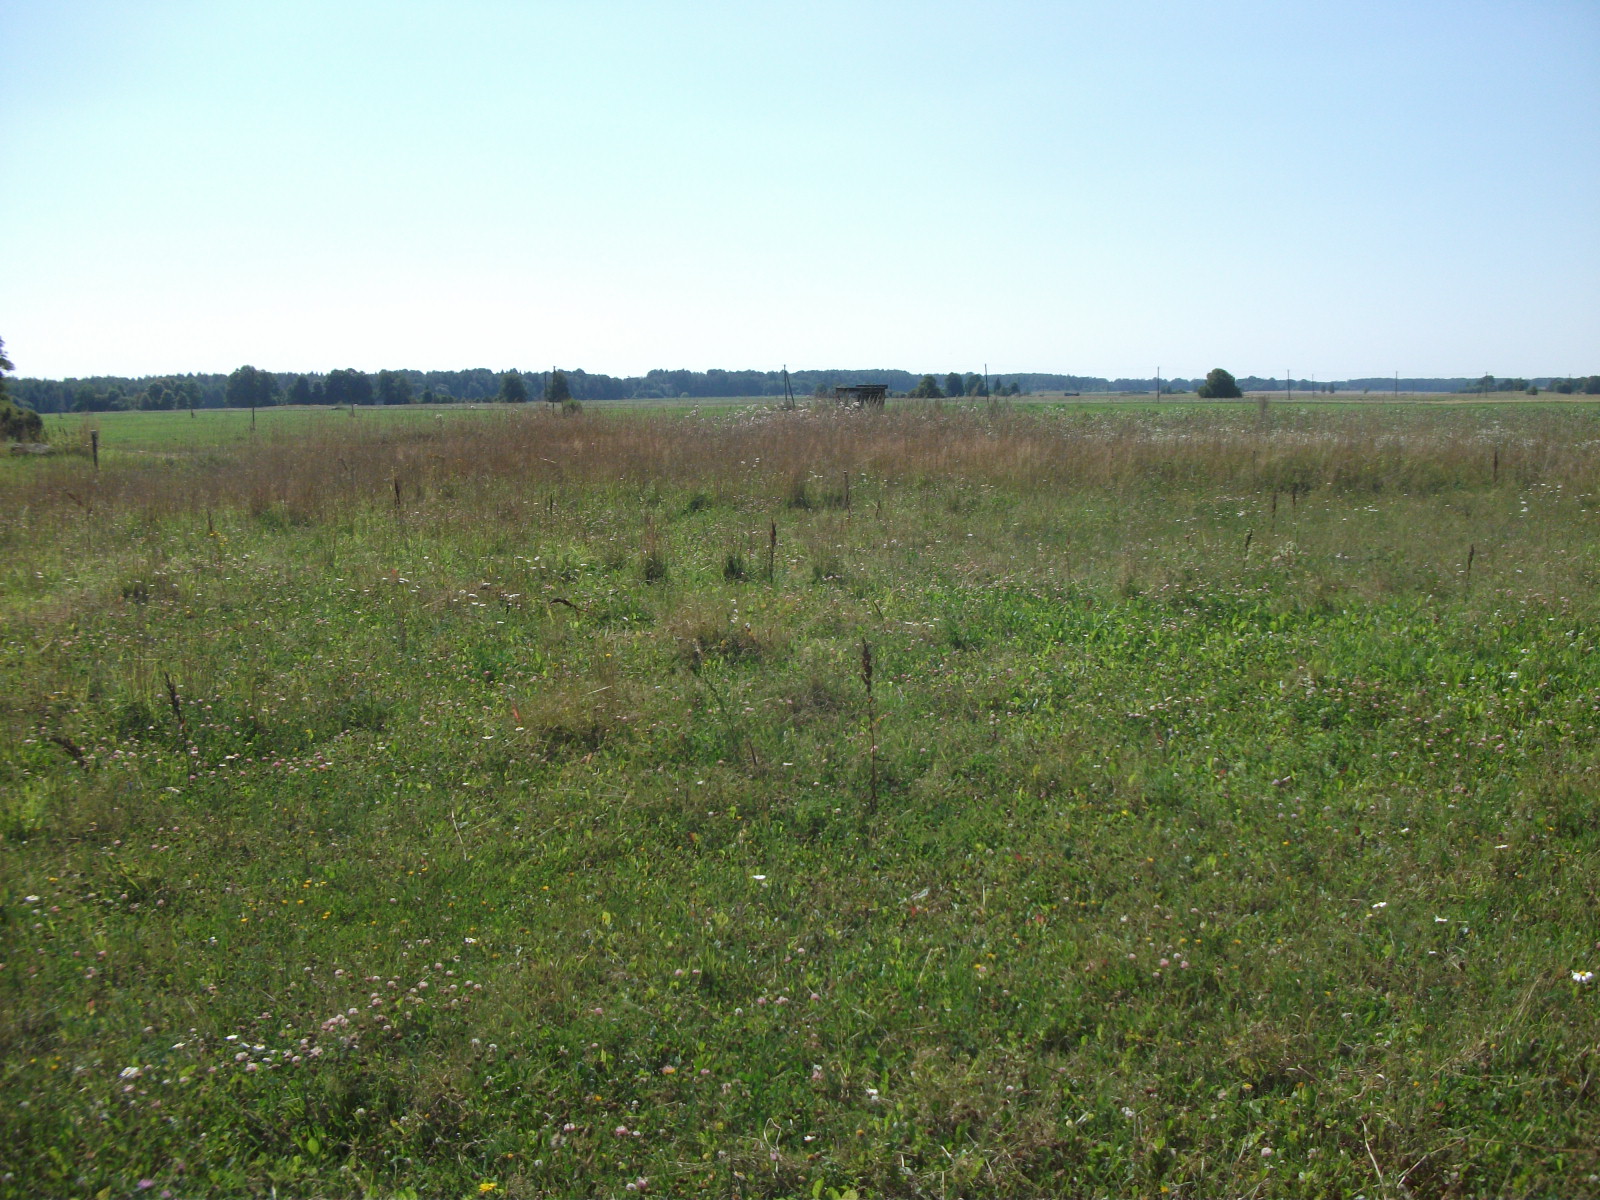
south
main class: Grassland
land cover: Grassland without tree/shrub cover
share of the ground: > 75 %
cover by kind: herbaceous plants 100 %
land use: Agriculture (excluding fallow land and kitchen gardens)
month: August
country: LV
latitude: 56.6534
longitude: 26.5075
